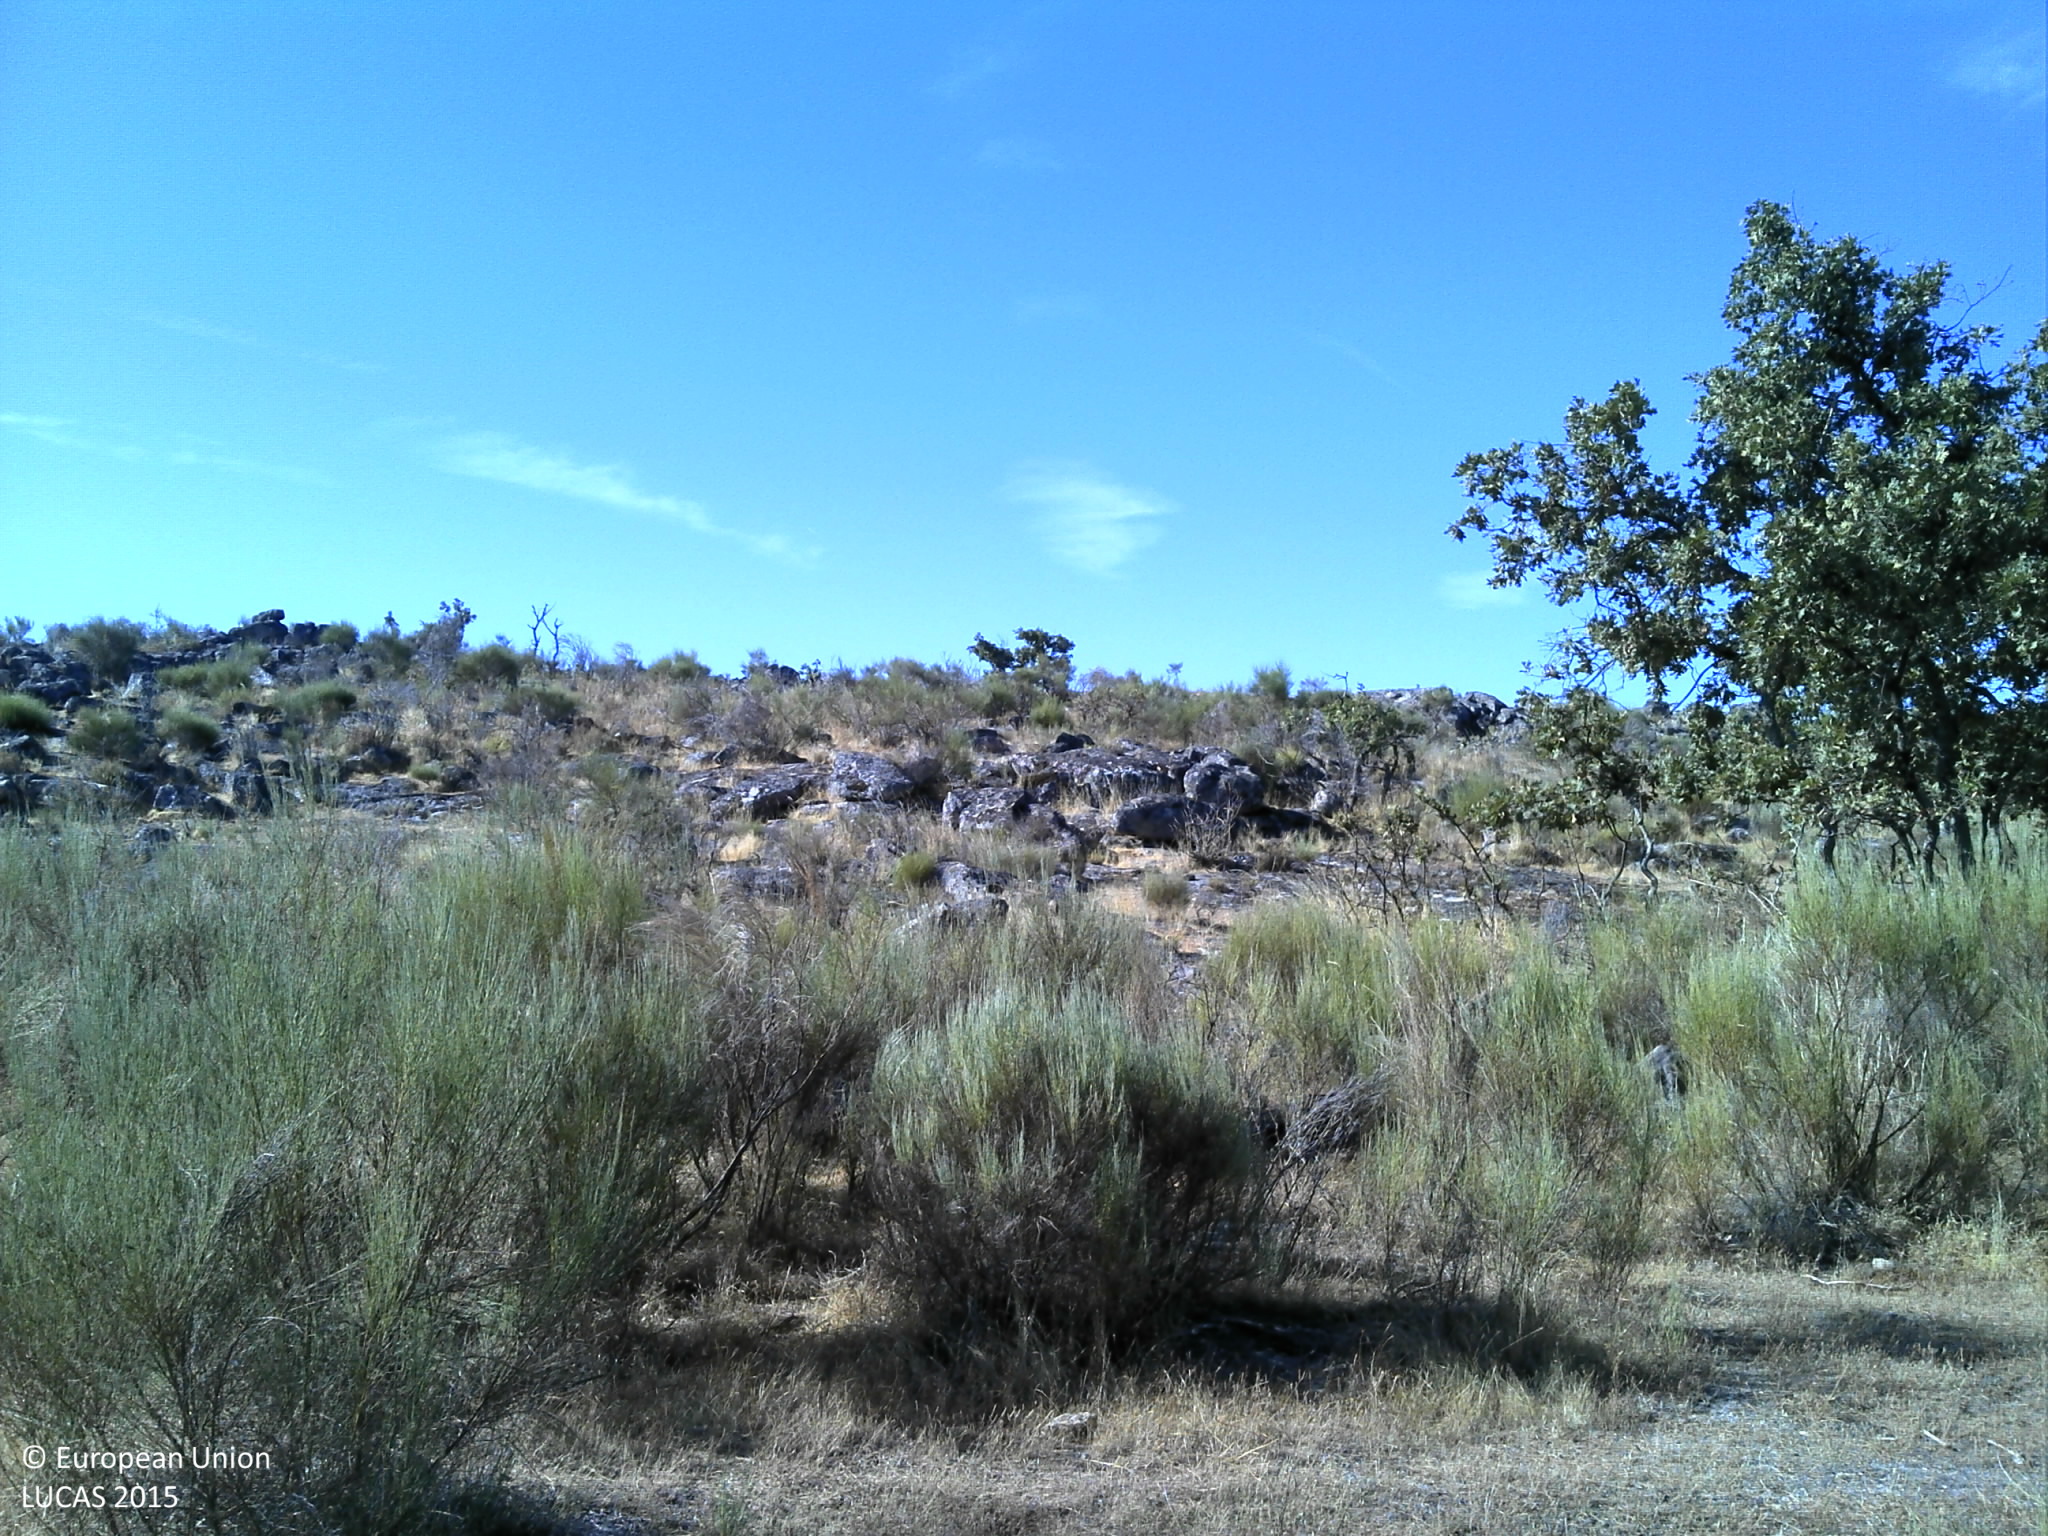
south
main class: Shrubland
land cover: Shrubland without tree cover
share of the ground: 50 - 75 %
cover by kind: shrubs 50 %, herbaceous plants 30 %, consolidated bare surface 20 %
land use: Agriculture (excluding fallow land and kitchen gardens)
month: August
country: PT
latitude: 39.4350
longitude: -7.4127
